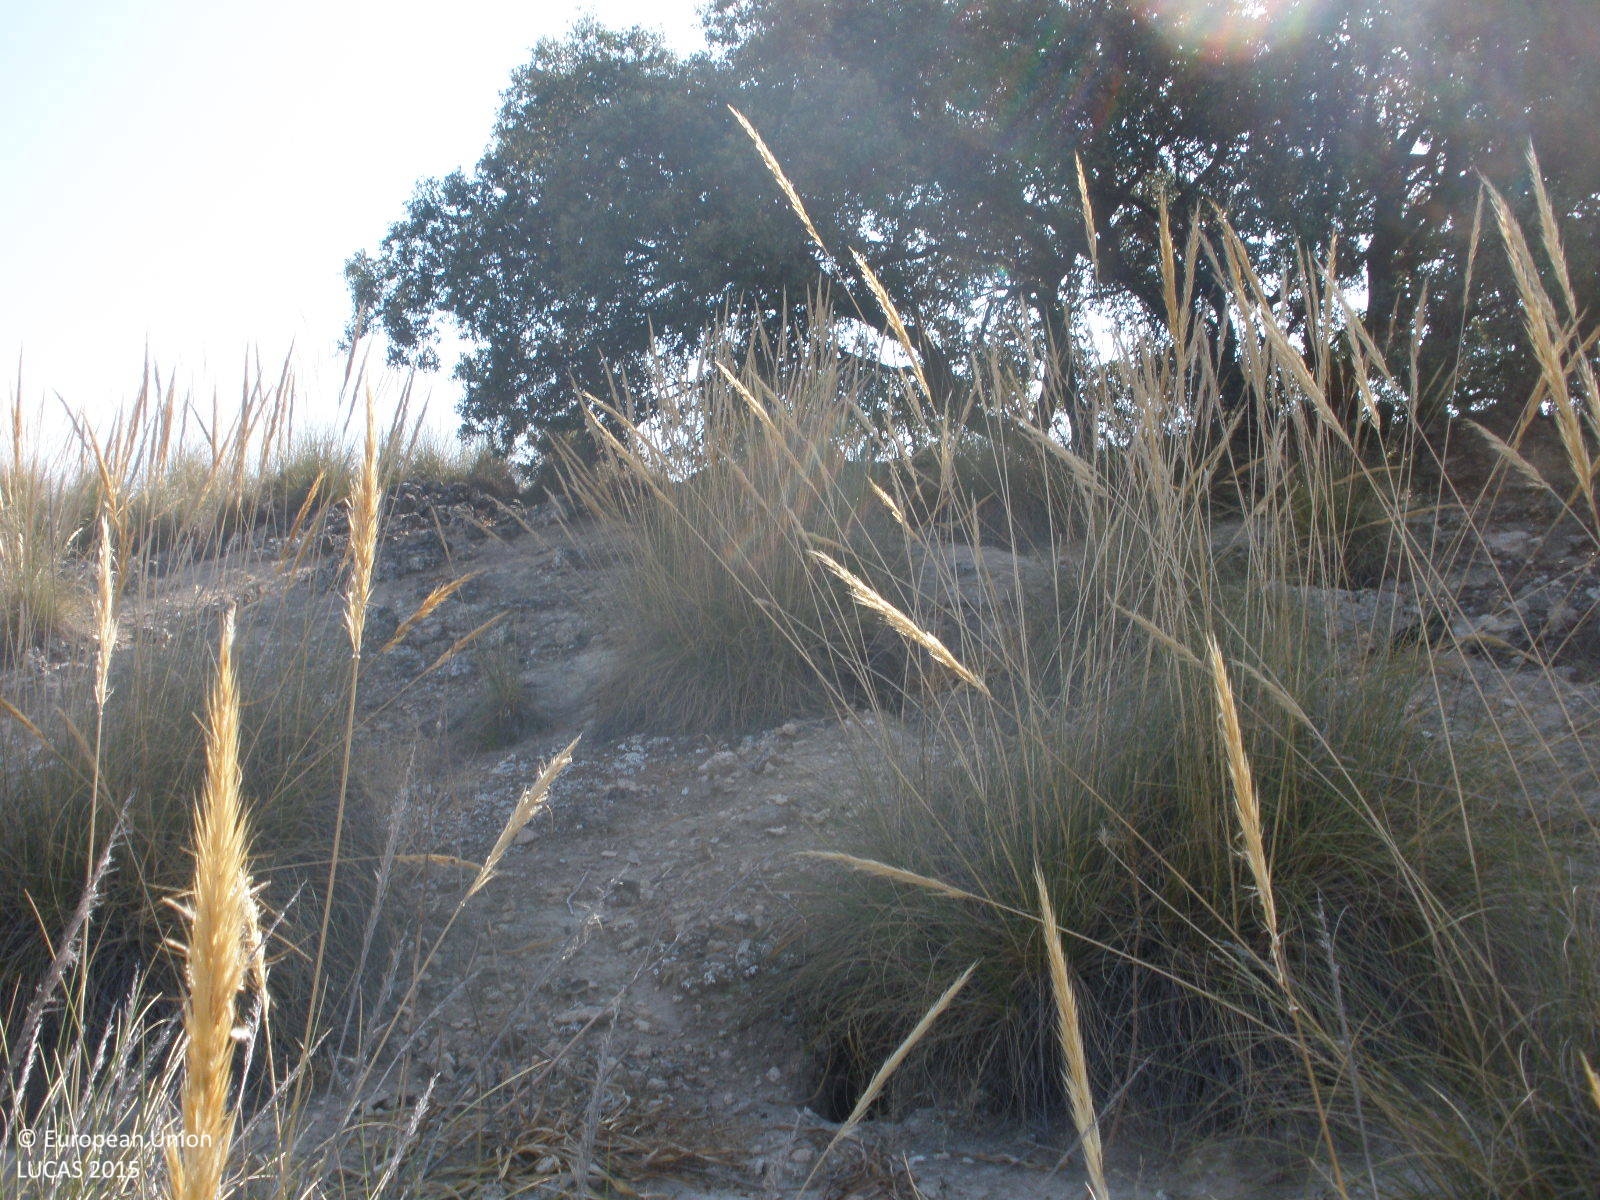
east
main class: Woodland
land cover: Broadleaved woodland
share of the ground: 25 - 50 %
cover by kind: shrubs 35 %, broadleaved forest trees 30 %, consolidated bare surface 25 %, herbaceous plants 10 %
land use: Semi-natural and natural areas not in use
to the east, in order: Broadleaved woodland; Shrubland without tree cover; Shrubland with sparse tree cover; Tracks; Pine dominated coniferous woodland; Grassland without tree/shrub cover; Grassland with sparse tree/shrub cover
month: June
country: ES
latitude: 40.1116
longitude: -3.2740
